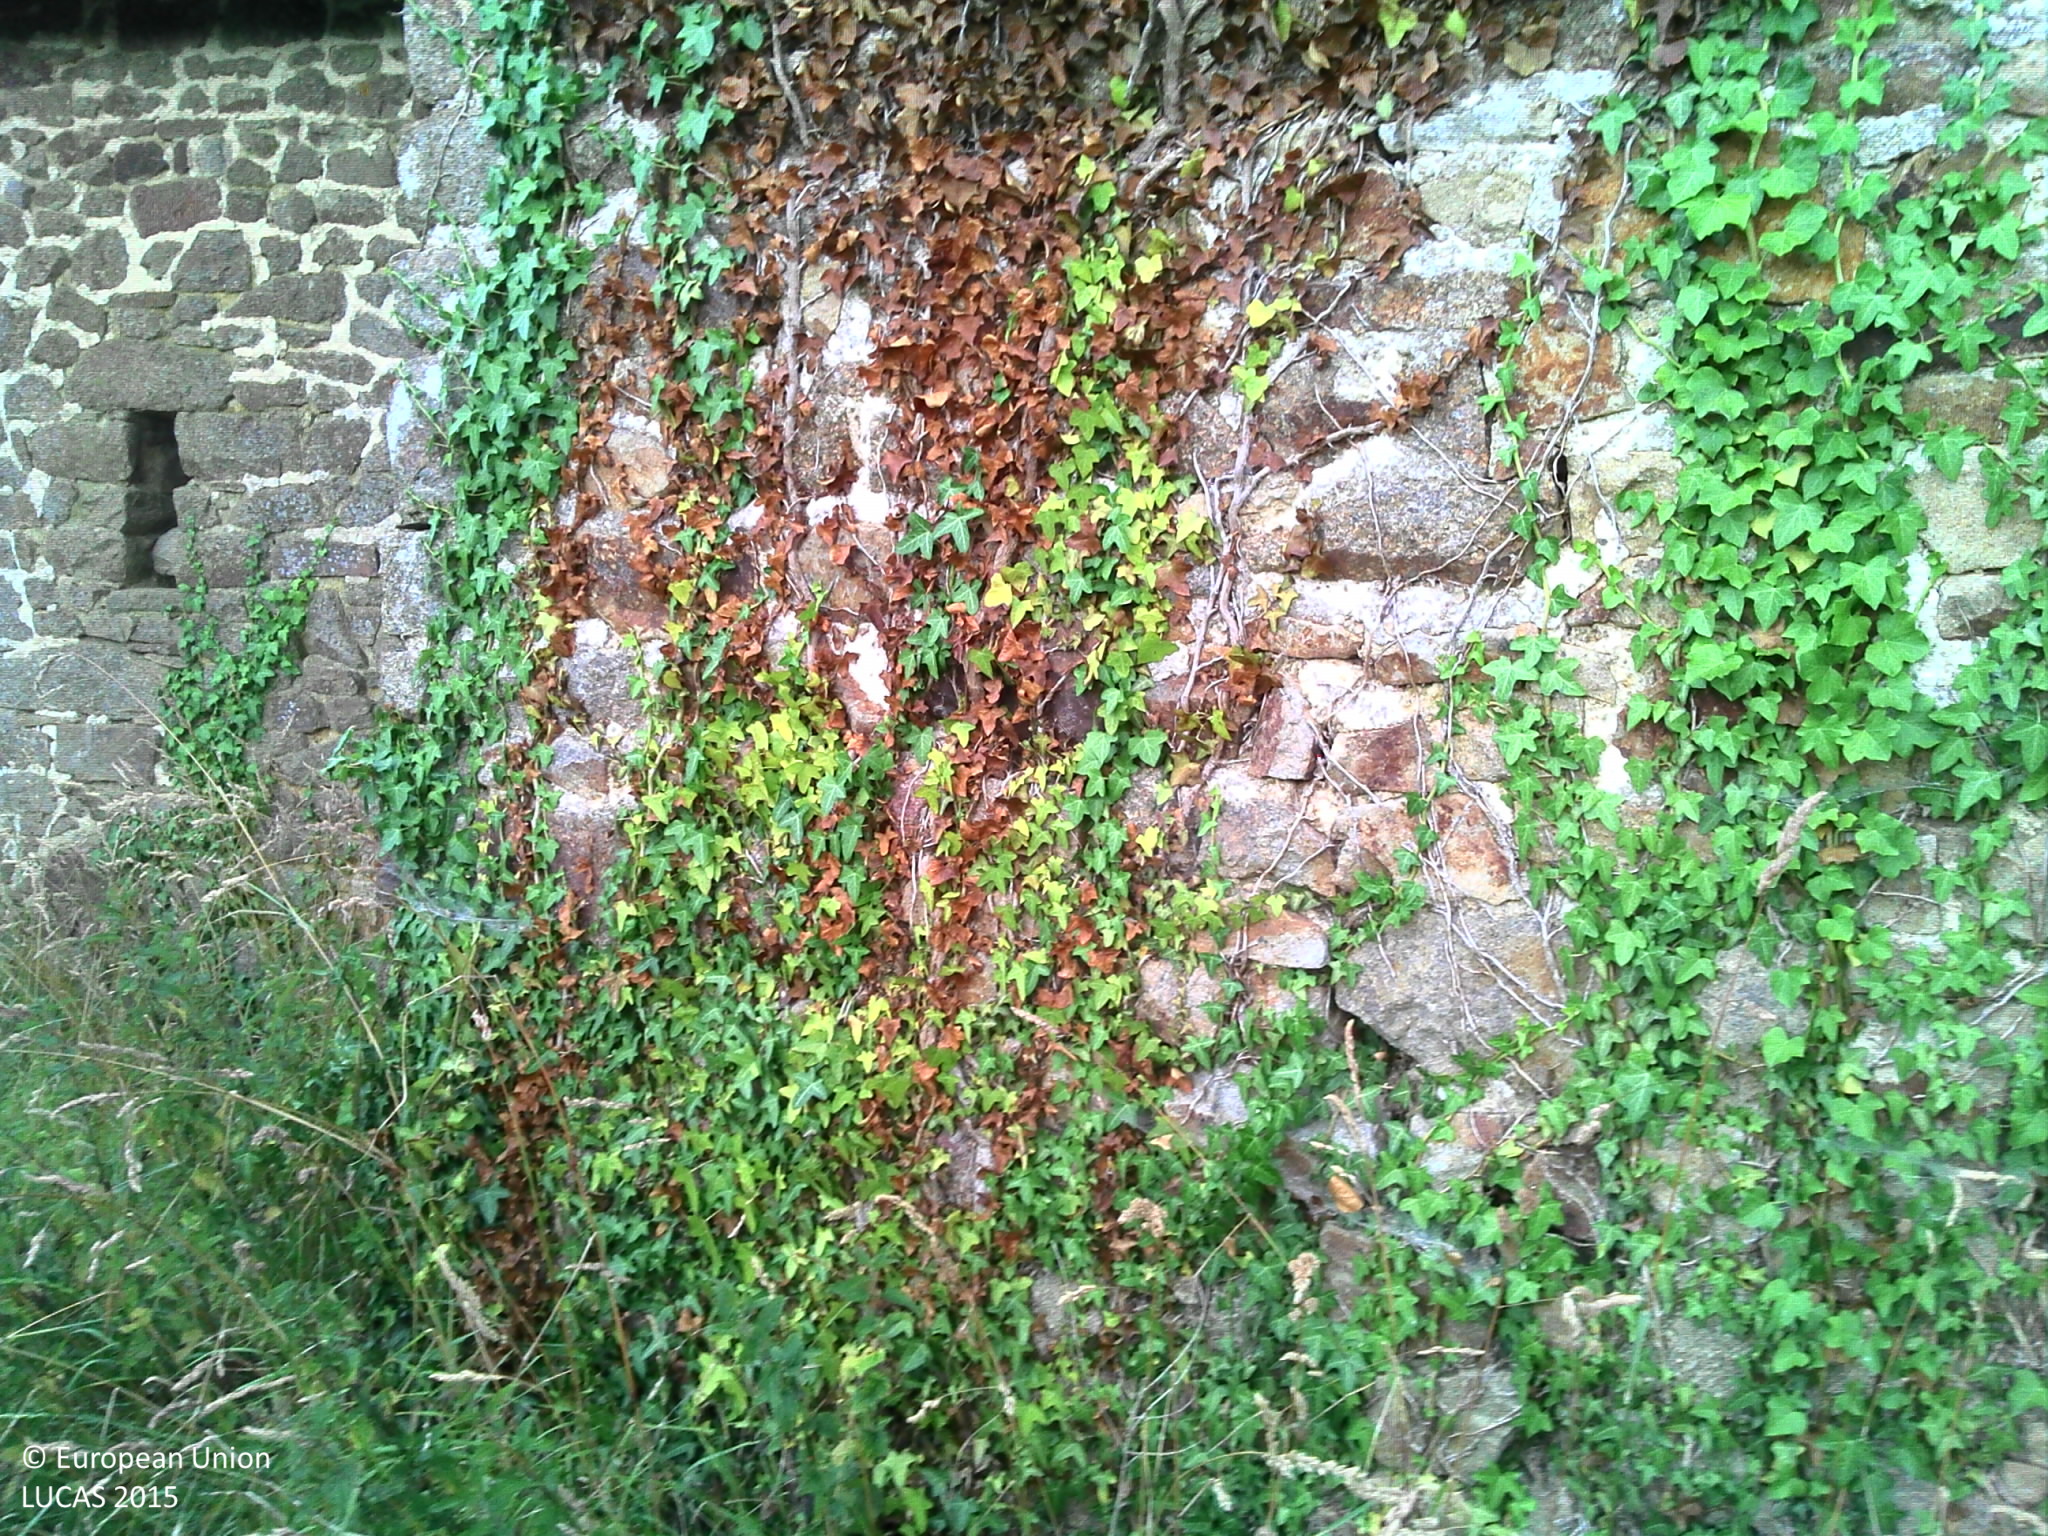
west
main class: Cropland
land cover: Maize
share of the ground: > 75 %
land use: Agriculture (excluding fallow land and kitchen gardens)
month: July
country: FR
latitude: 48.2728
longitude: -1.1576
